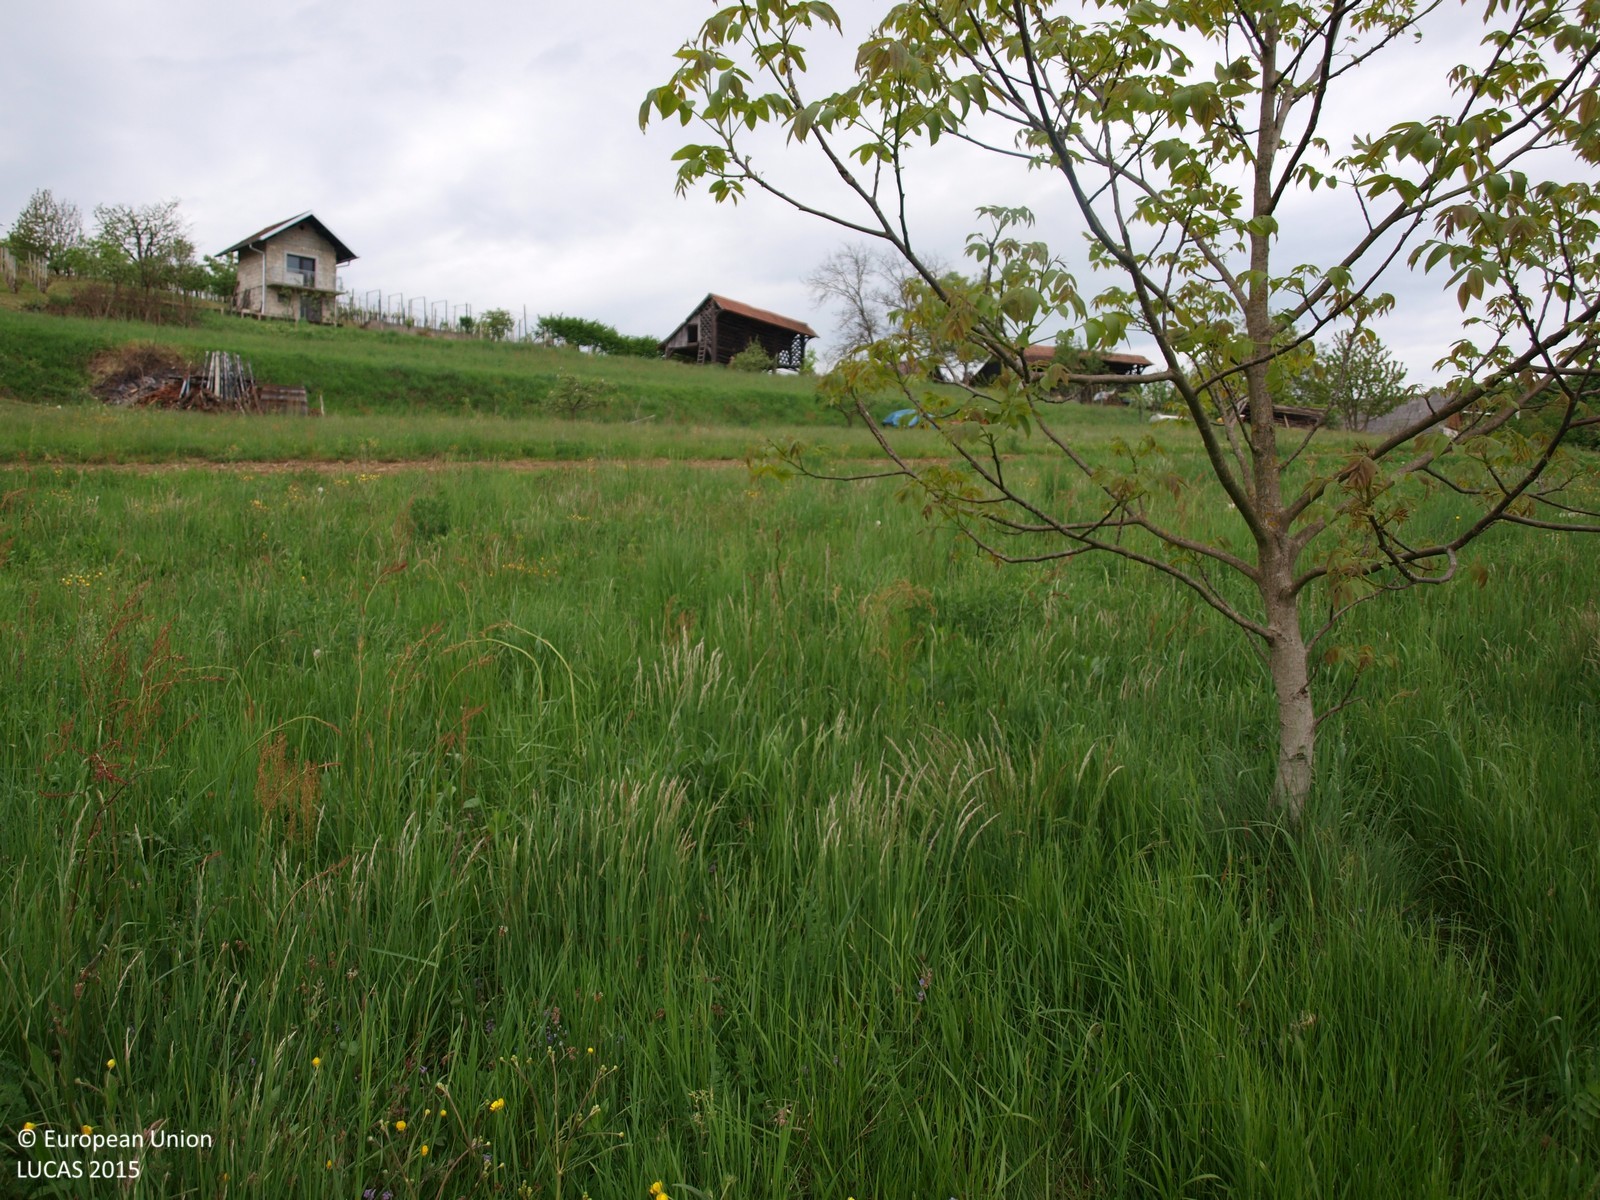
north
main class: Grassland
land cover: Grassland with sparse tree/shrub cover
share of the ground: > 75 %
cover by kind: herbaceous plants 90 %, broadleaved forest trees 5 %, shrubs 5 %
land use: Agriculture (excluding fallow land and kitchen gardens)
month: May
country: HR
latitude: 45.8214
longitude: 15.6735
